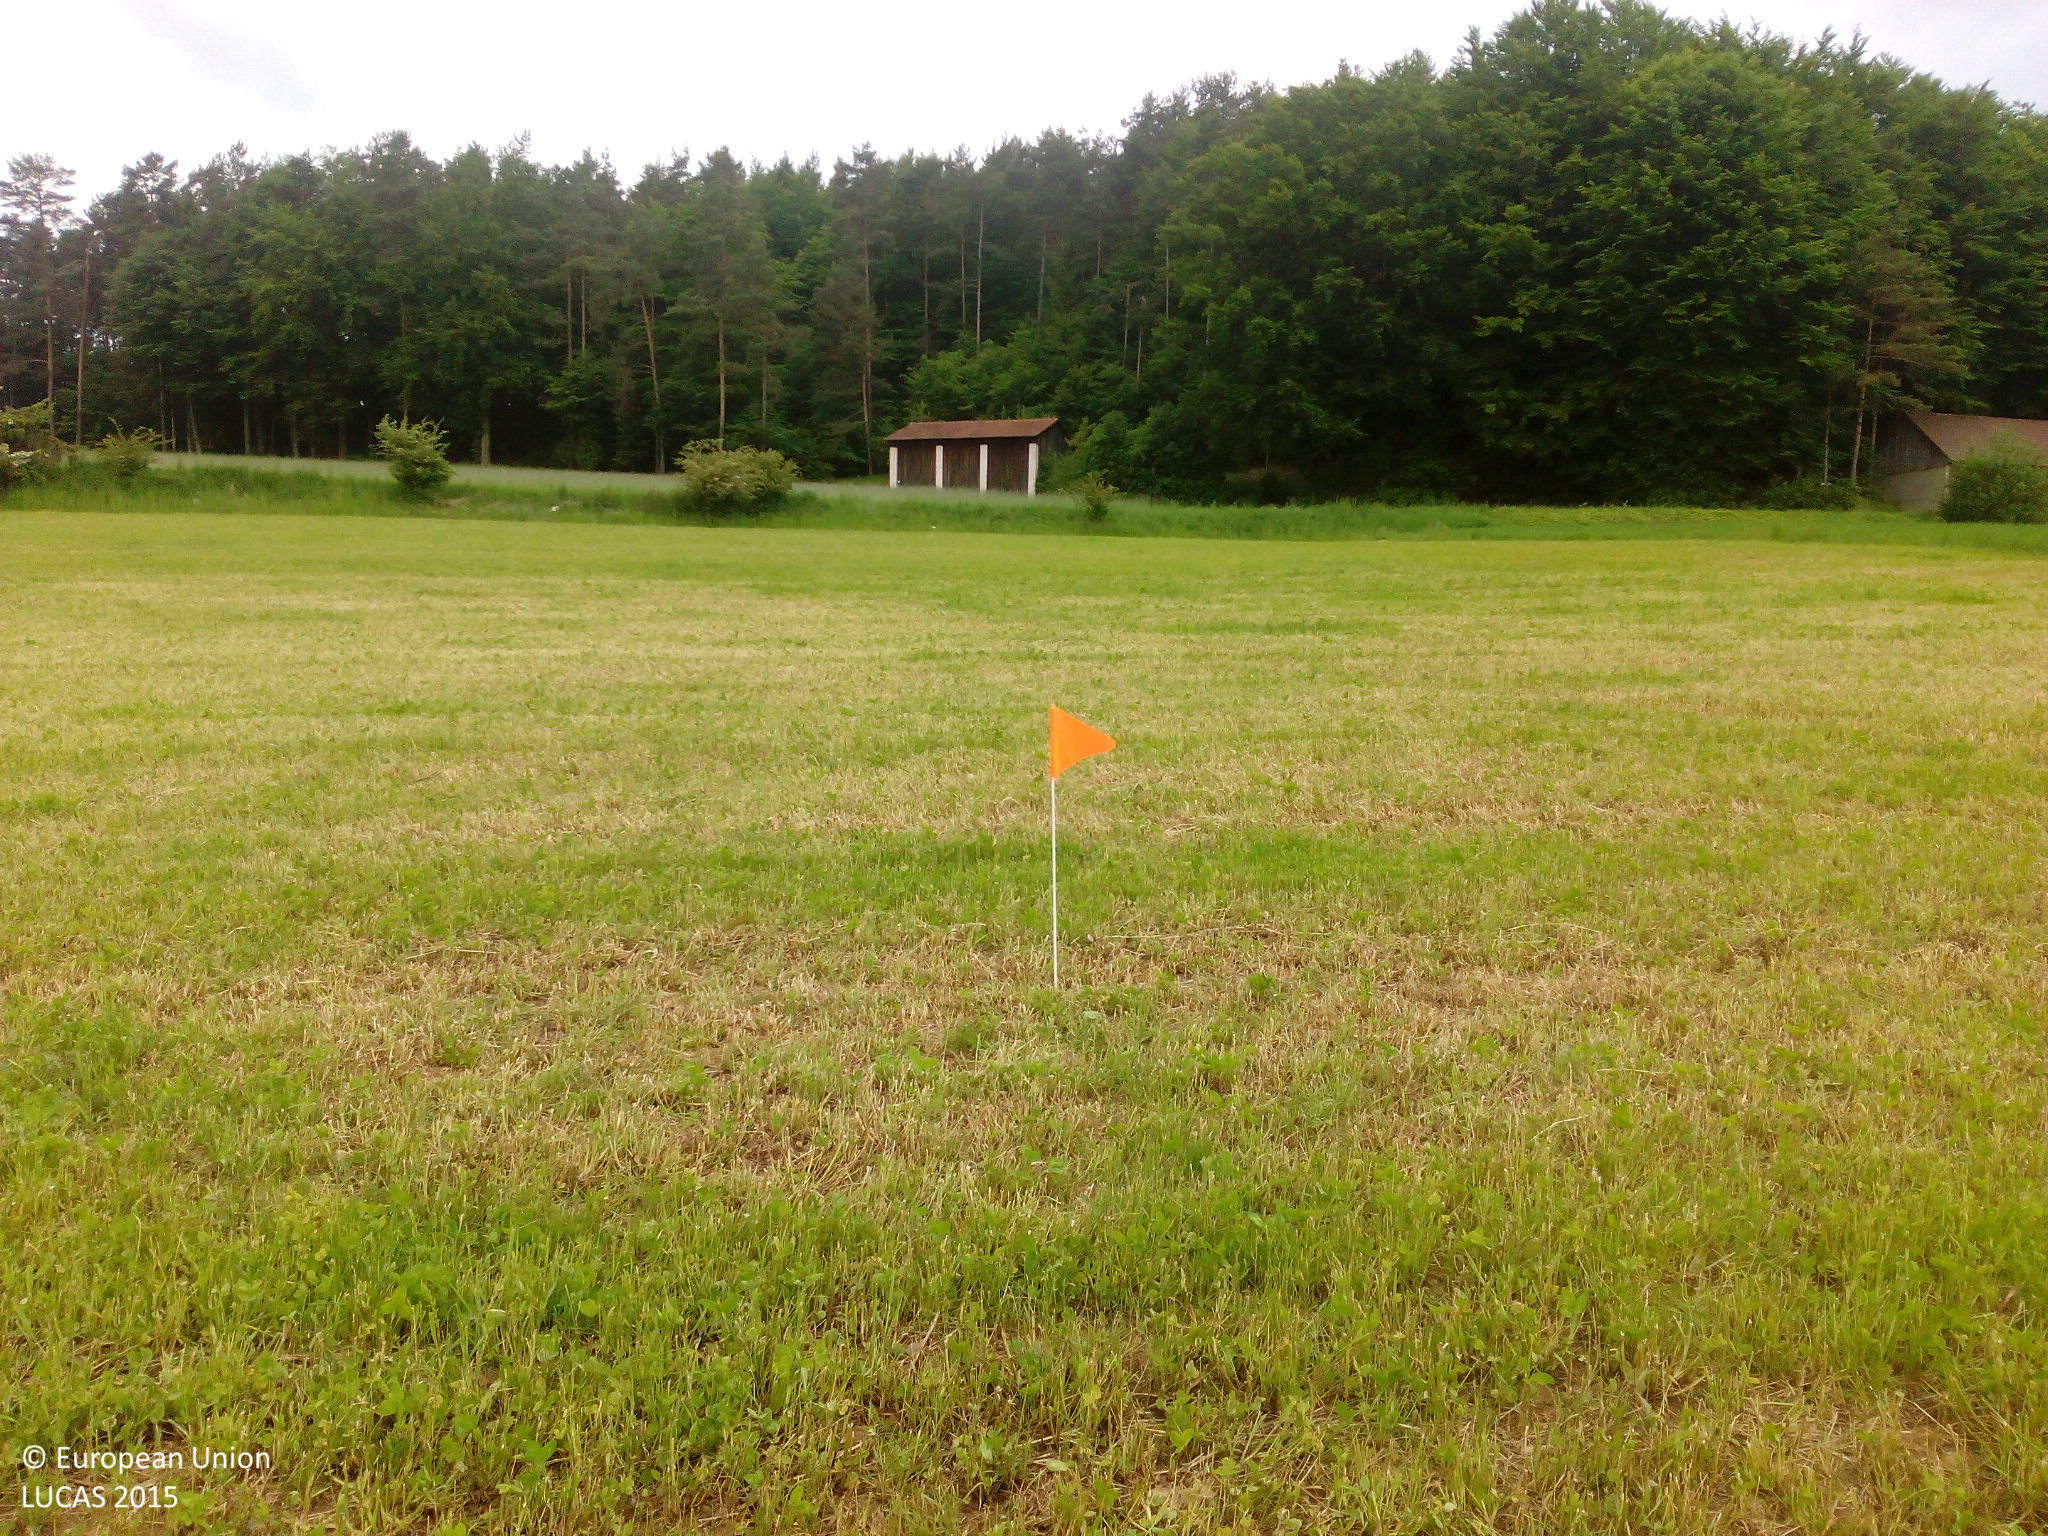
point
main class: Cropland
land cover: Temporary grasslands
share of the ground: > 75 %
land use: Agriculture (excluding fallow land and kitchen gardens)
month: May
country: DE
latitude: 49.7792
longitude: 11.4578
